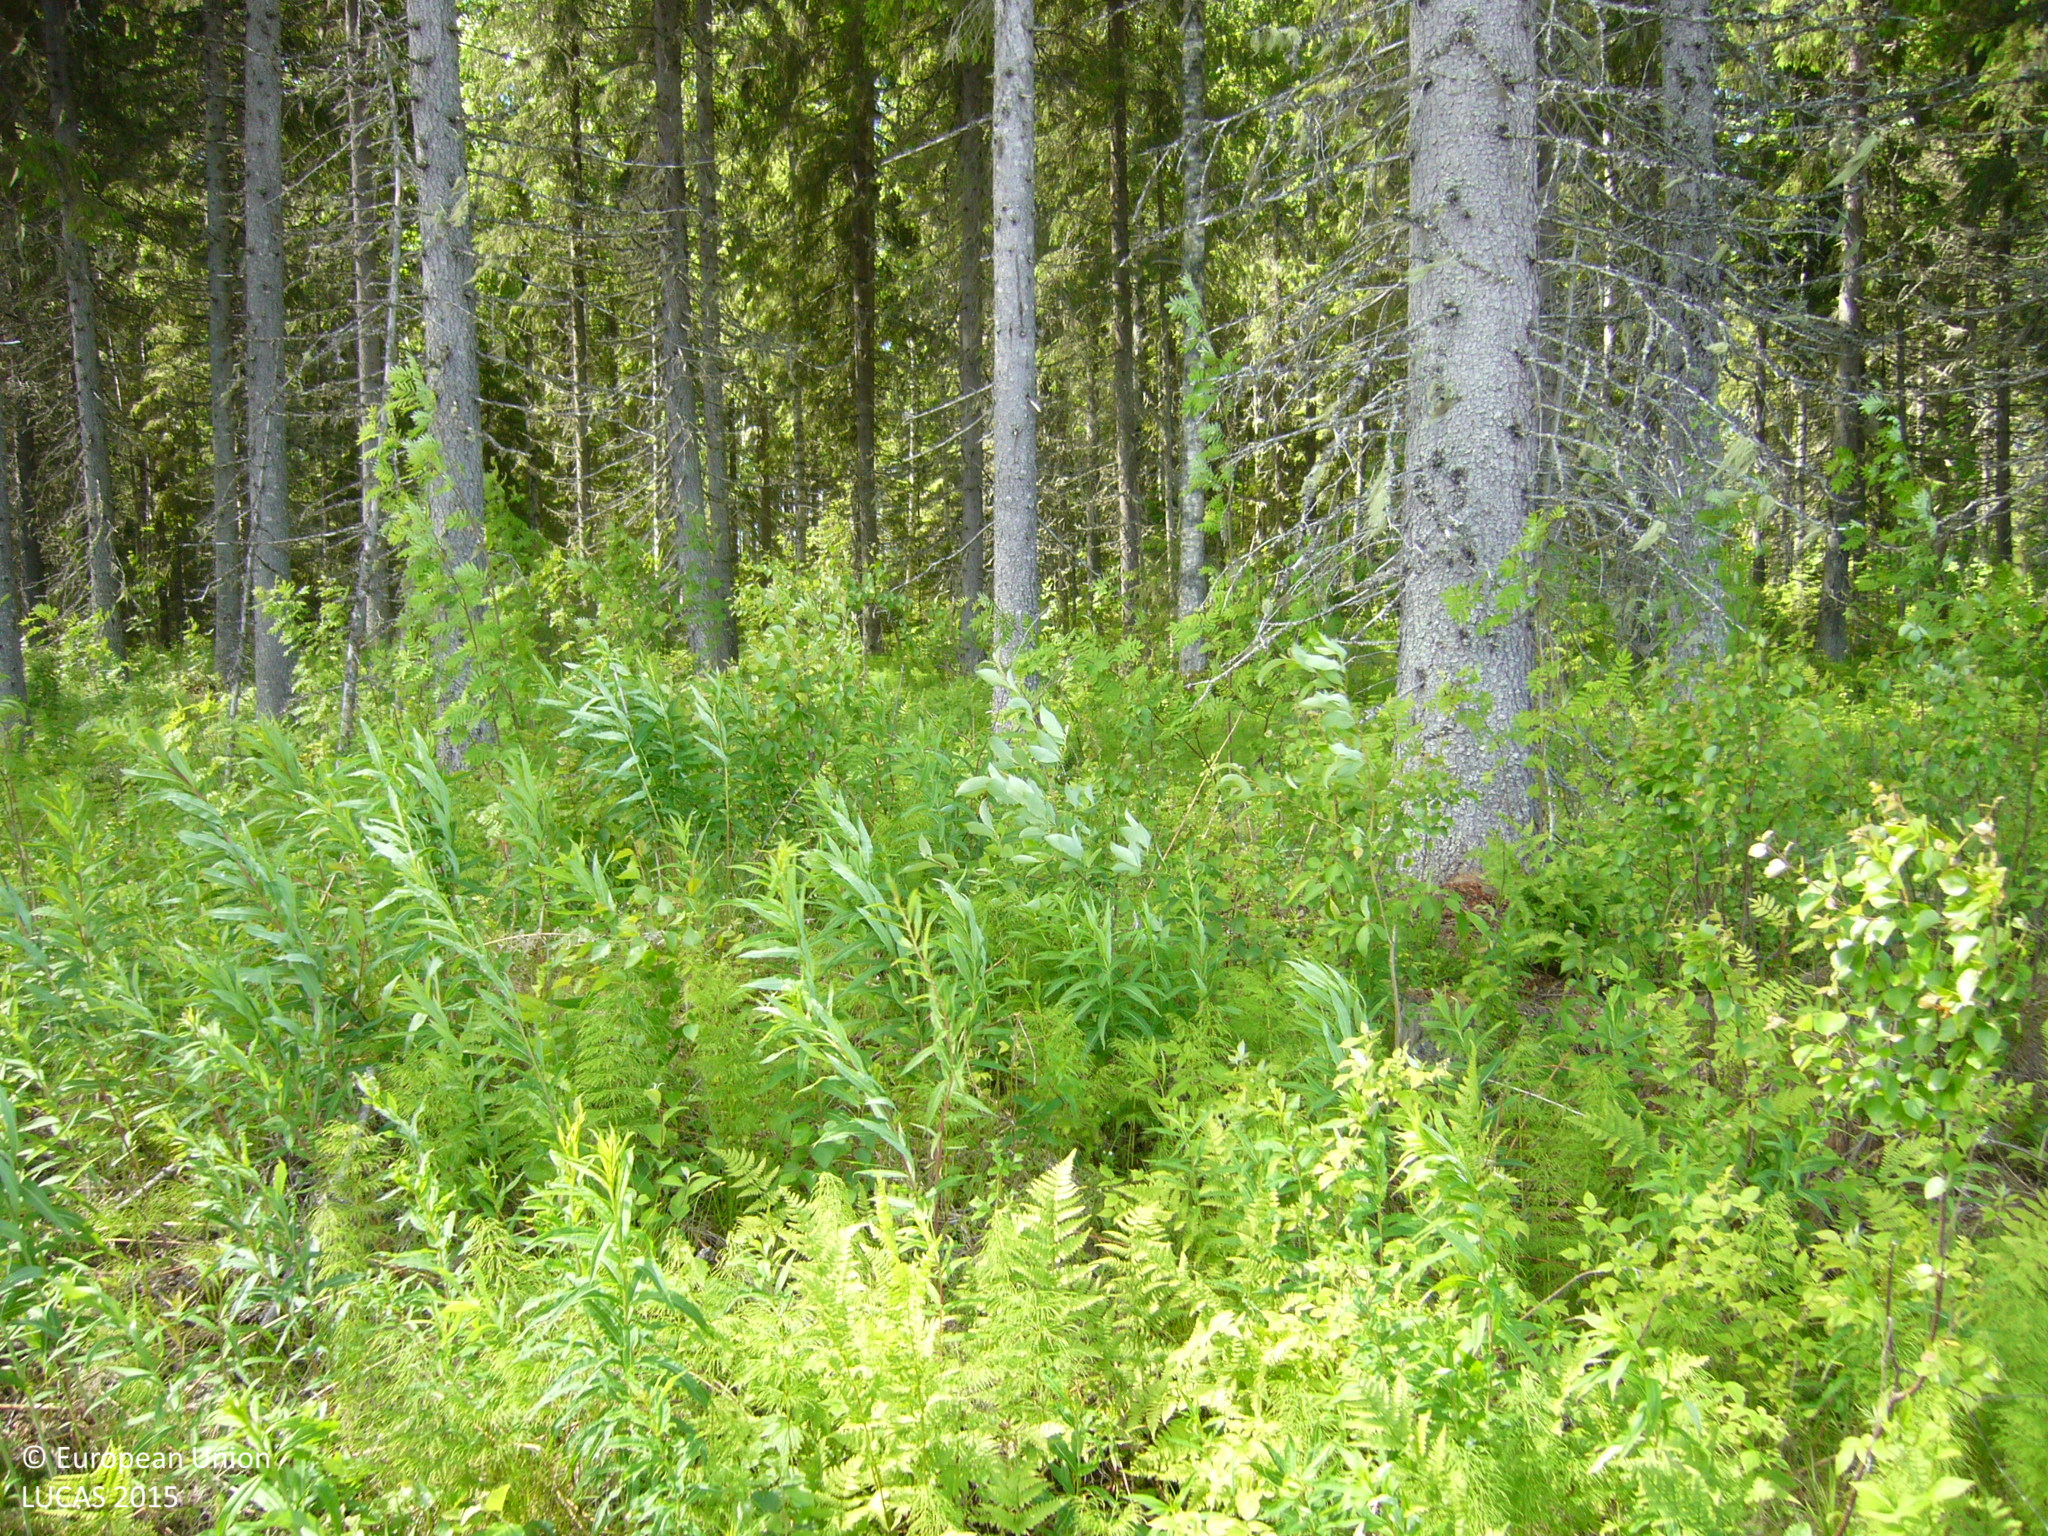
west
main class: Shrubland
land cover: Shrubland without tree cover
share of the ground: 10 - 25 %
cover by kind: herbaceous plants 50 %, shrubs 20 %, consolidated bare surface 10 %, unconsolidated bare surface 10 %
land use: Forestry
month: July
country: FI
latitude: 63.5387
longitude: 26.0247
